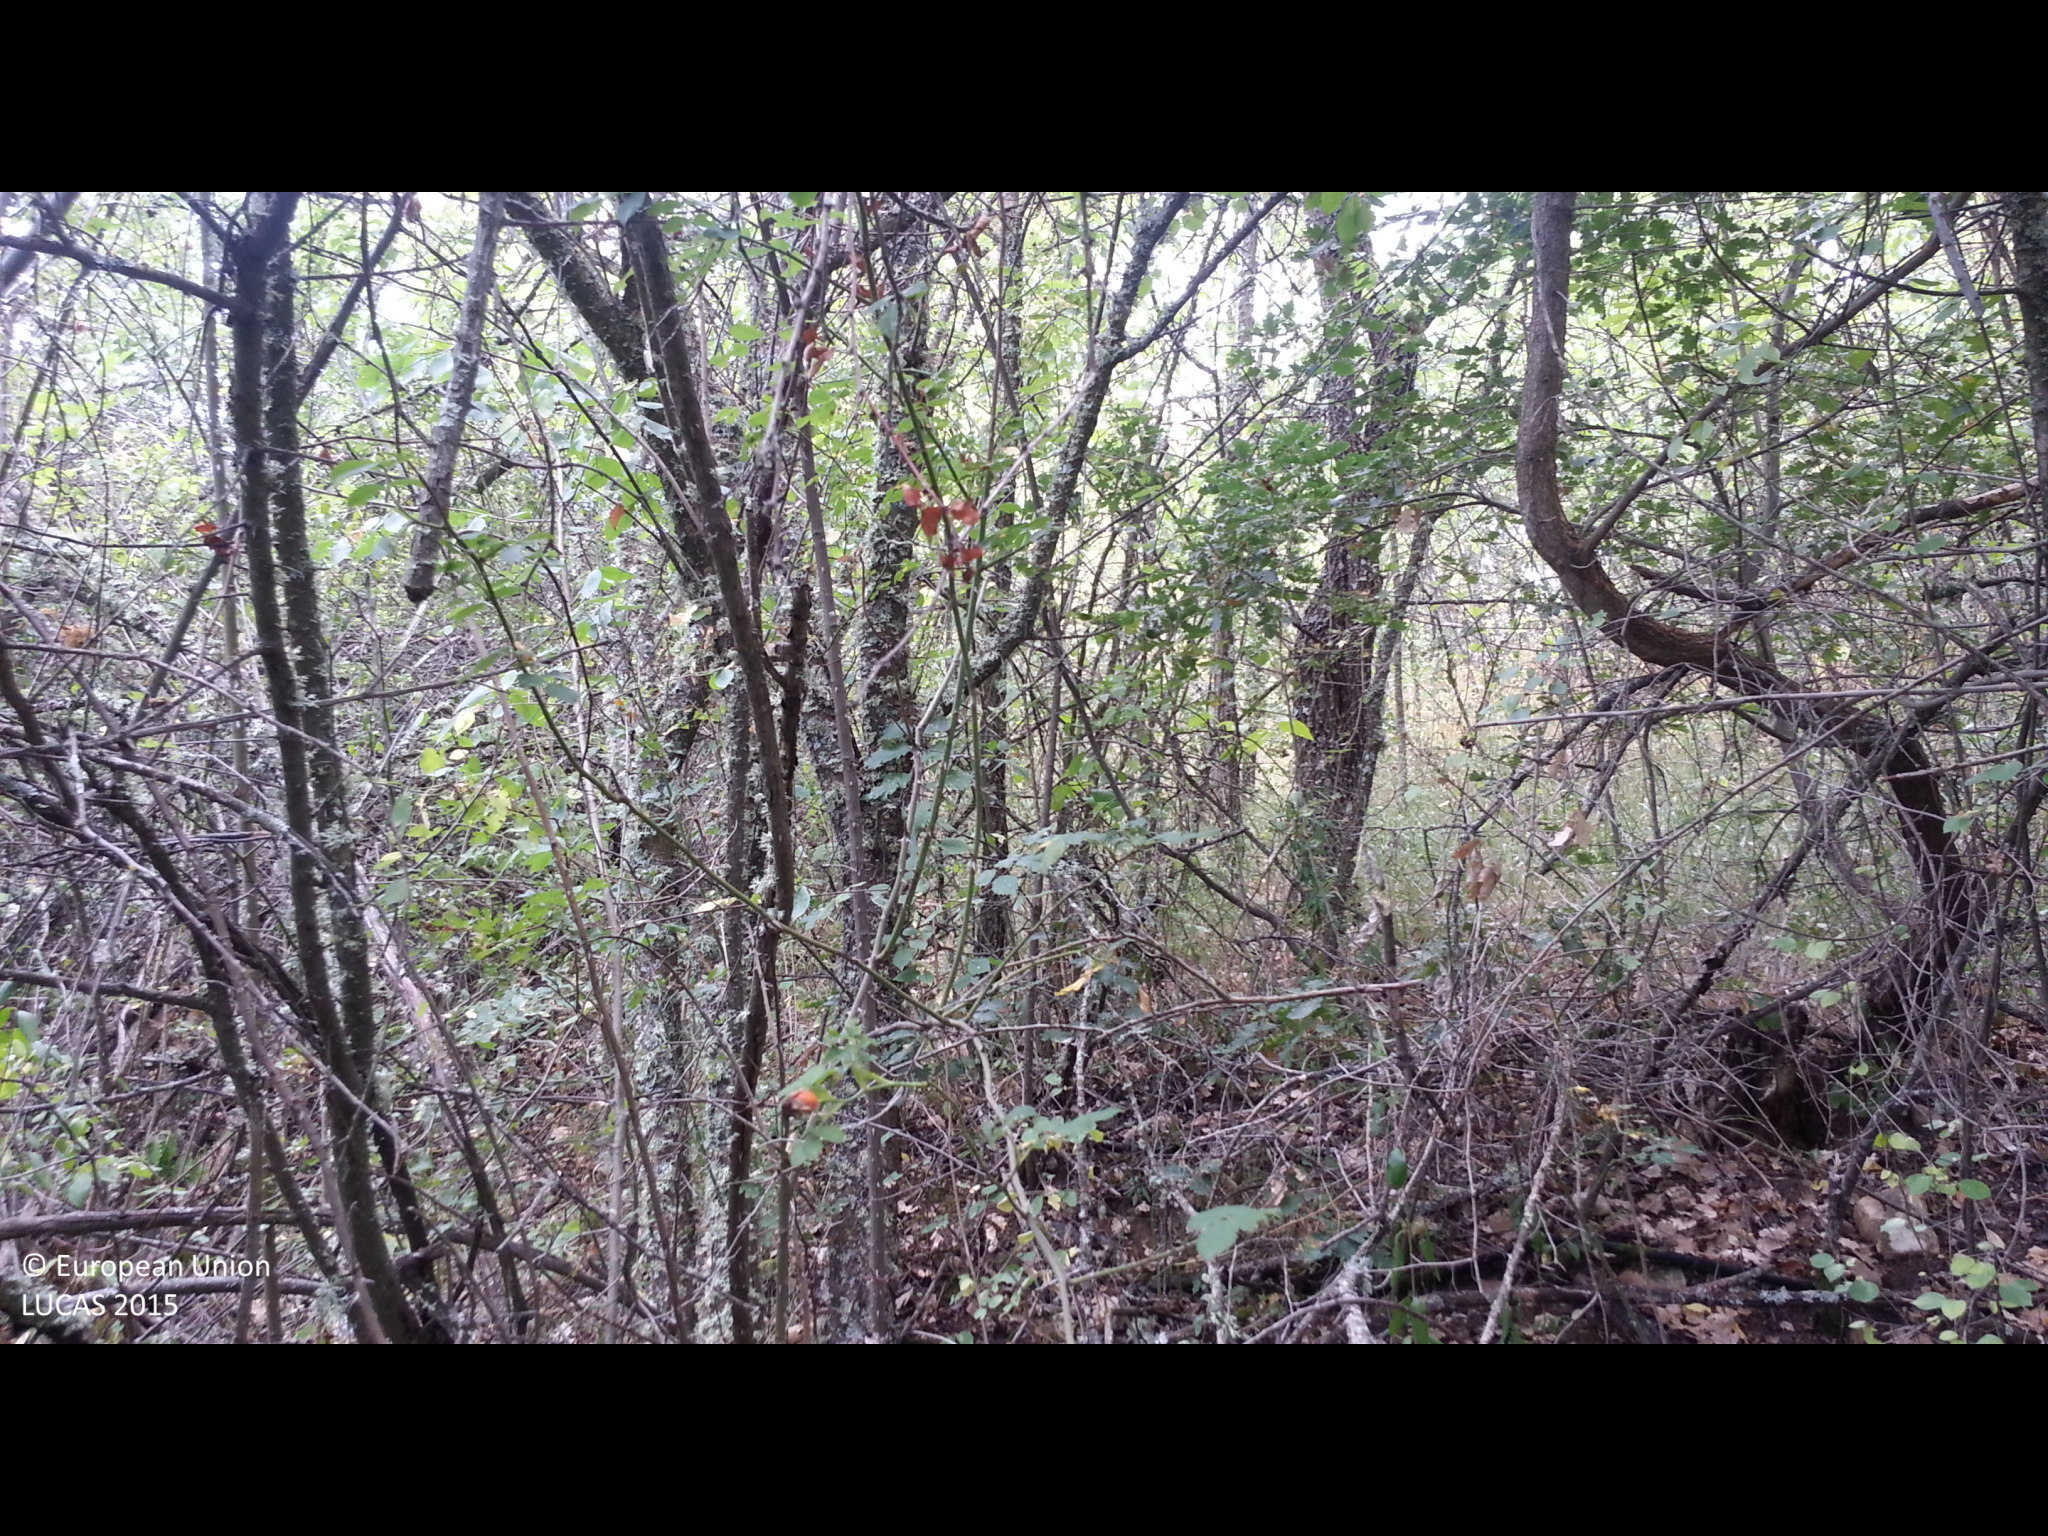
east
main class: Woodland
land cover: Broadleaved woodland
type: mesophytic deciduous forest
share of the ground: > 75 %
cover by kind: broadleaved forest trees 95 %, shrubs 5 %
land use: Forestry
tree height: < 5 m
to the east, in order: Broadleaved woodland; Spontaneously vegetated surfaces; Grassland without tree/shrub cover
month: September
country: BG
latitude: 42.3492
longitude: 22.6591
